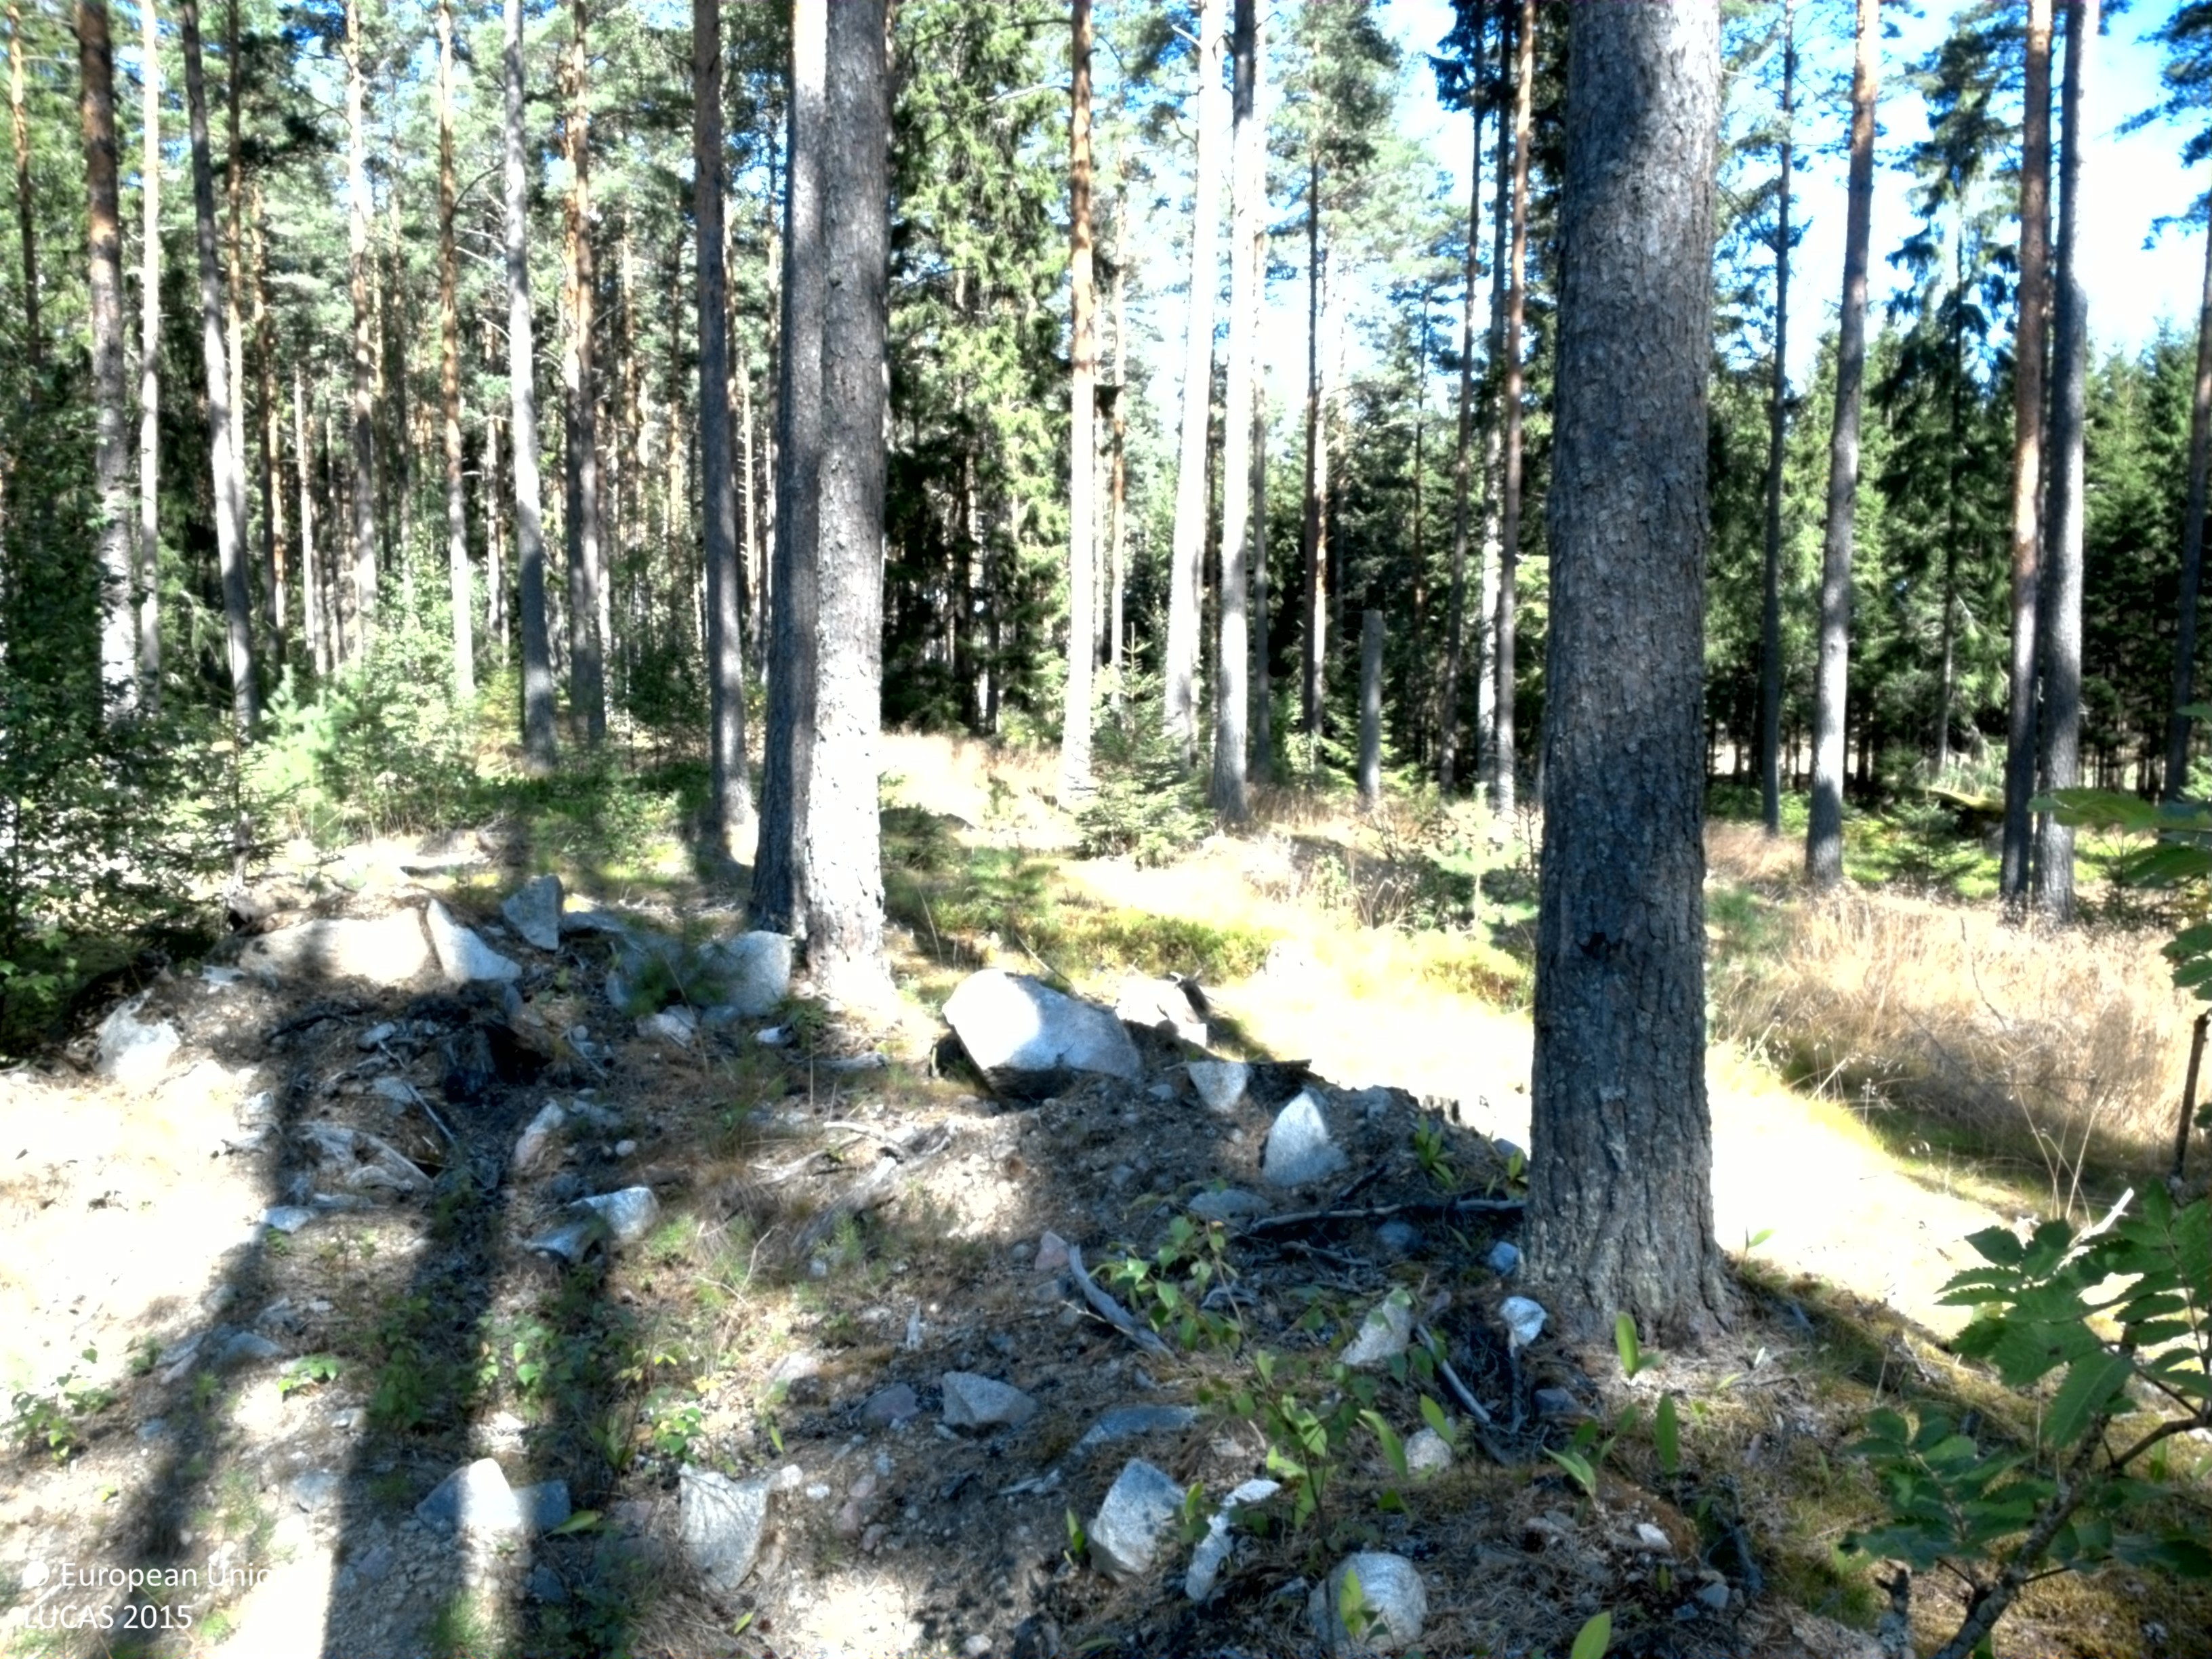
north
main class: Woodland
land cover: Pine dominated coniferous woodland
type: boreal forest
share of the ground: 50 - 75 %
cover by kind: coniferous forest trees 50 %, shrubs 20 %, lichens and mosses 20 %, broadleaved forest trees 5 %, herbaceous plants 5 %
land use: Forestry
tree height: > 5 m
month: August
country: SE
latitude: 59.7810
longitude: 16.8143
